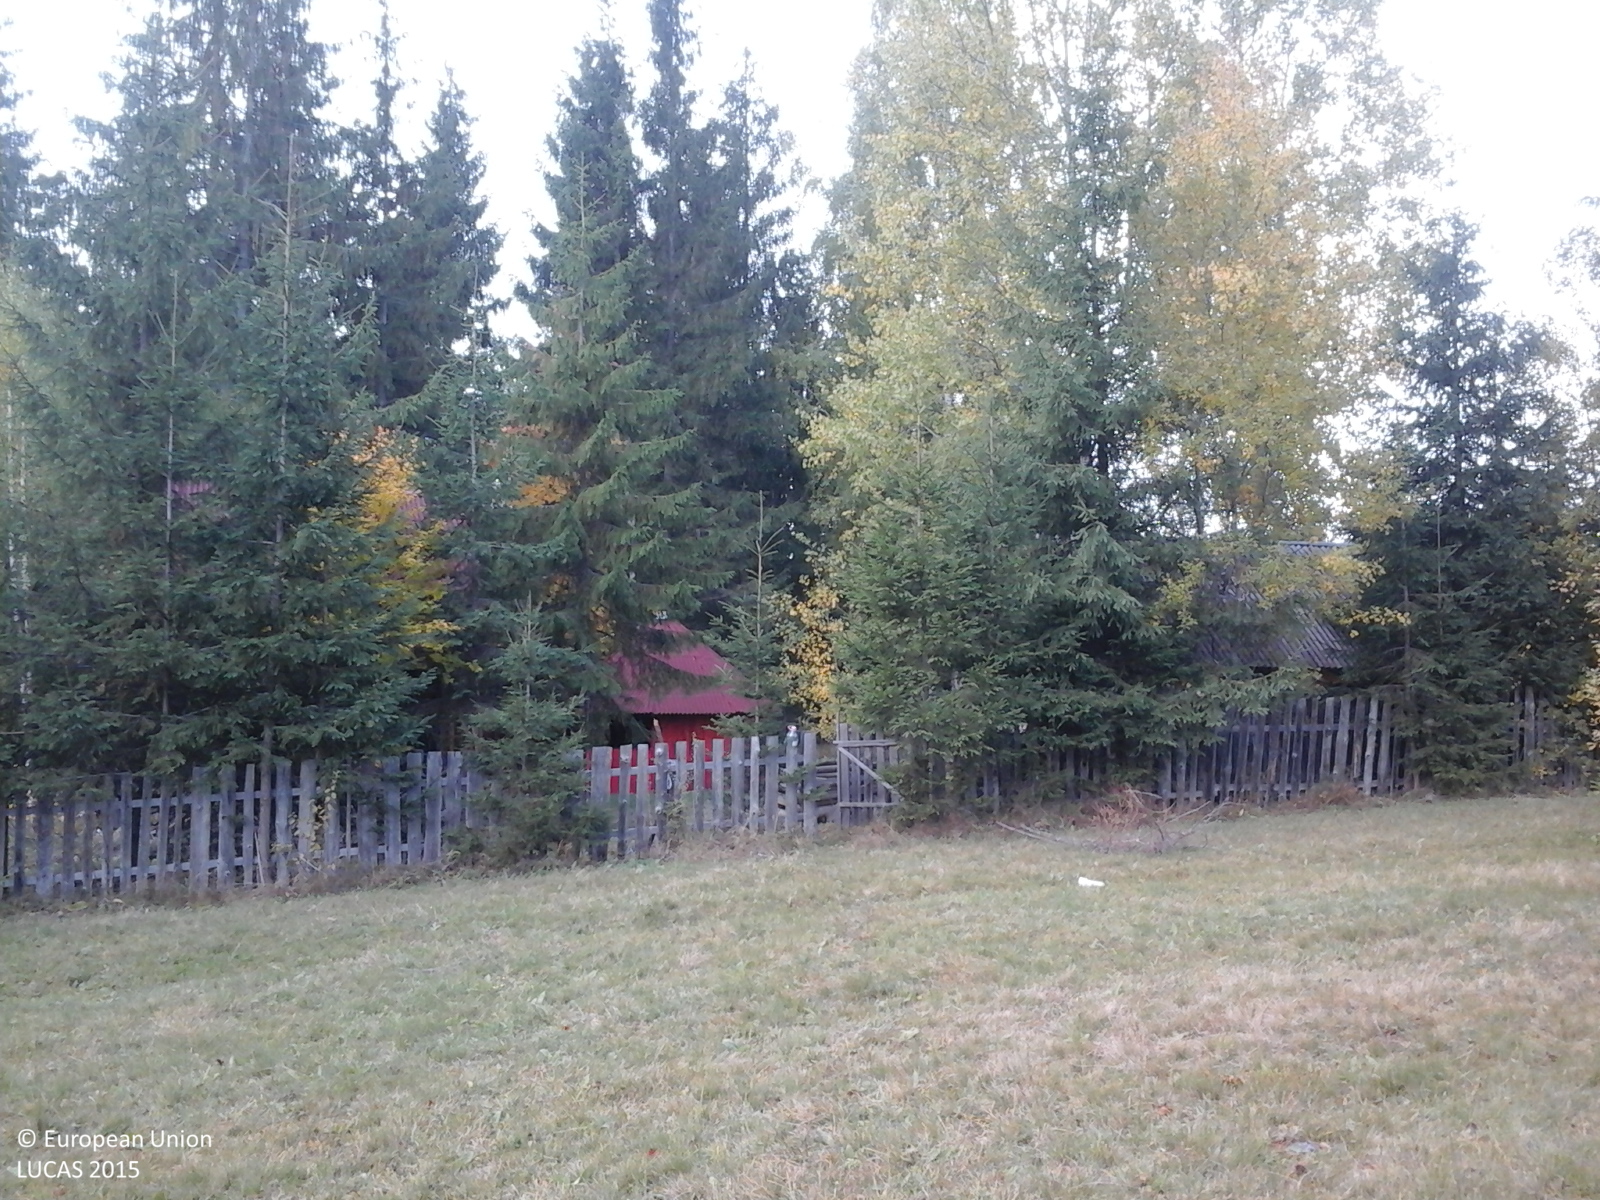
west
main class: Grassland
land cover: Grassland without tree/shrub cover
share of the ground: > 75 %
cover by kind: herbaceous plants 100 %
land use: Agriculture (excluding fallow land and kitchen gardens)
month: October
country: RO
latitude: 46.5488
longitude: 25.5120
